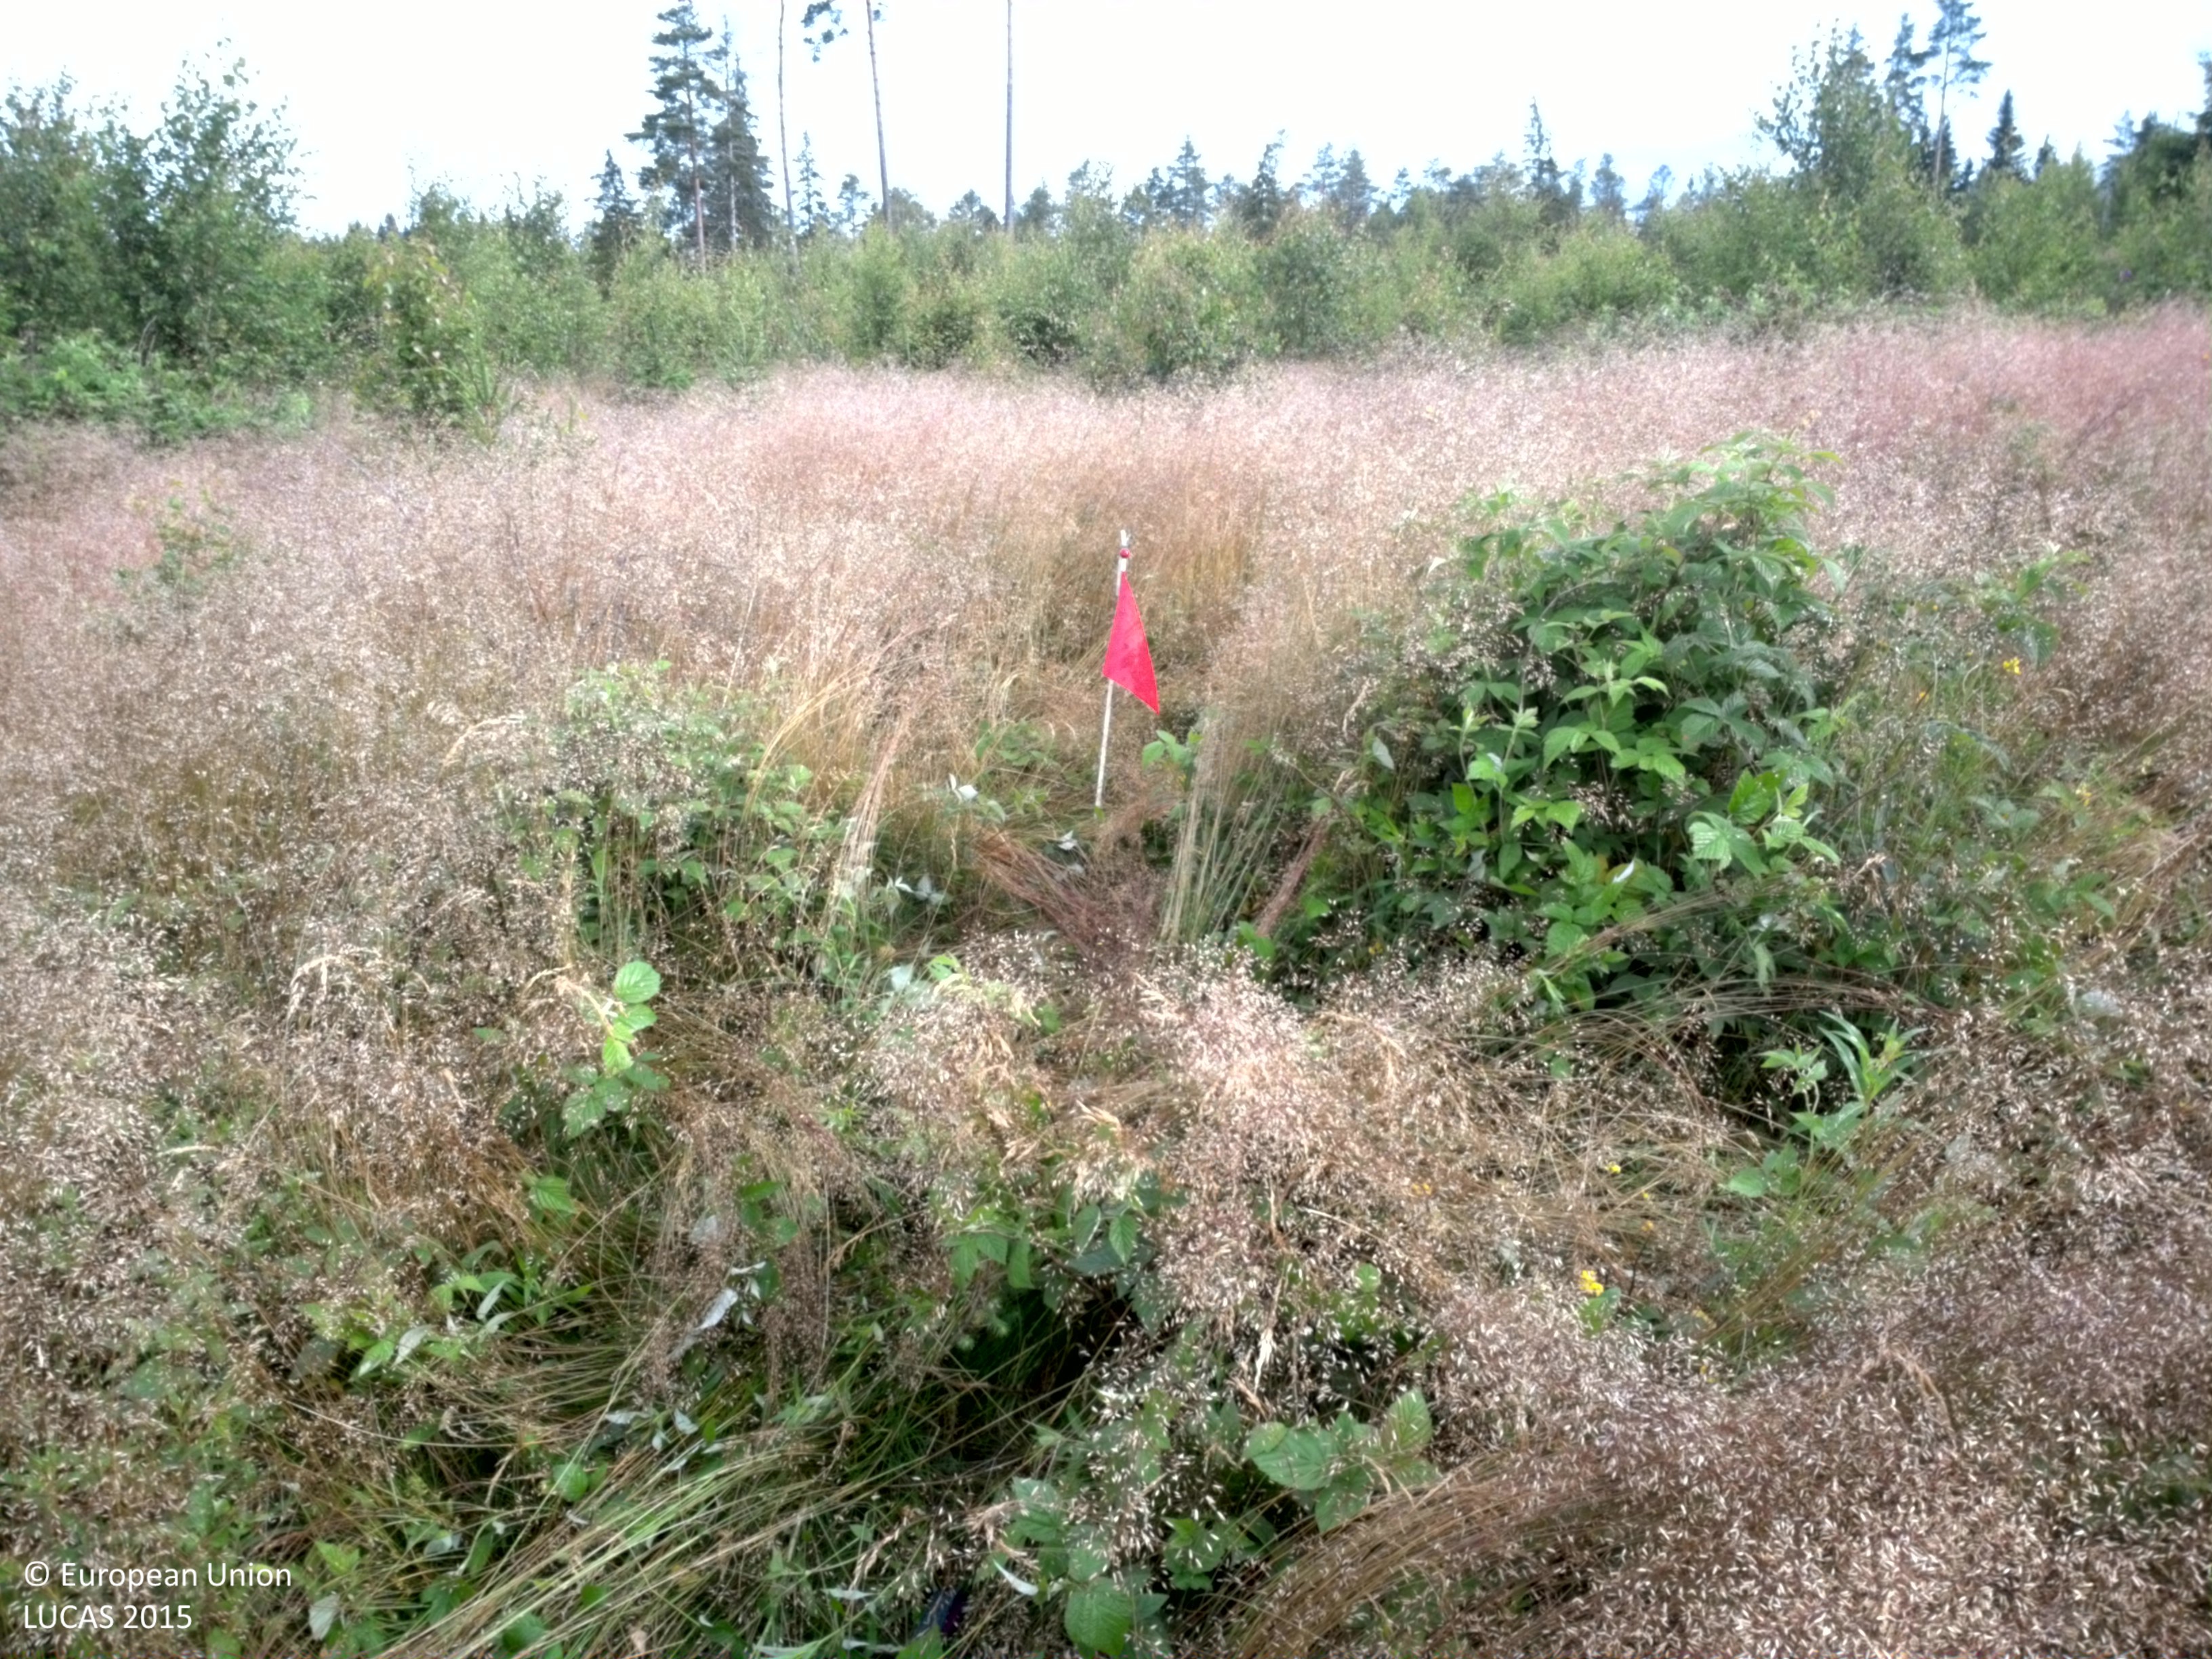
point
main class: Grassland
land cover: Grassland with sparse tree/shrub cover
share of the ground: > 75 %
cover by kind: herbaceous plants 90 %, coniferous forest trees 5 %, shrubs 5 %
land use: Forestry
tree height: < 5 m
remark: Clear cut
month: July
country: SE
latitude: 57.7272
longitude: 14.5794
